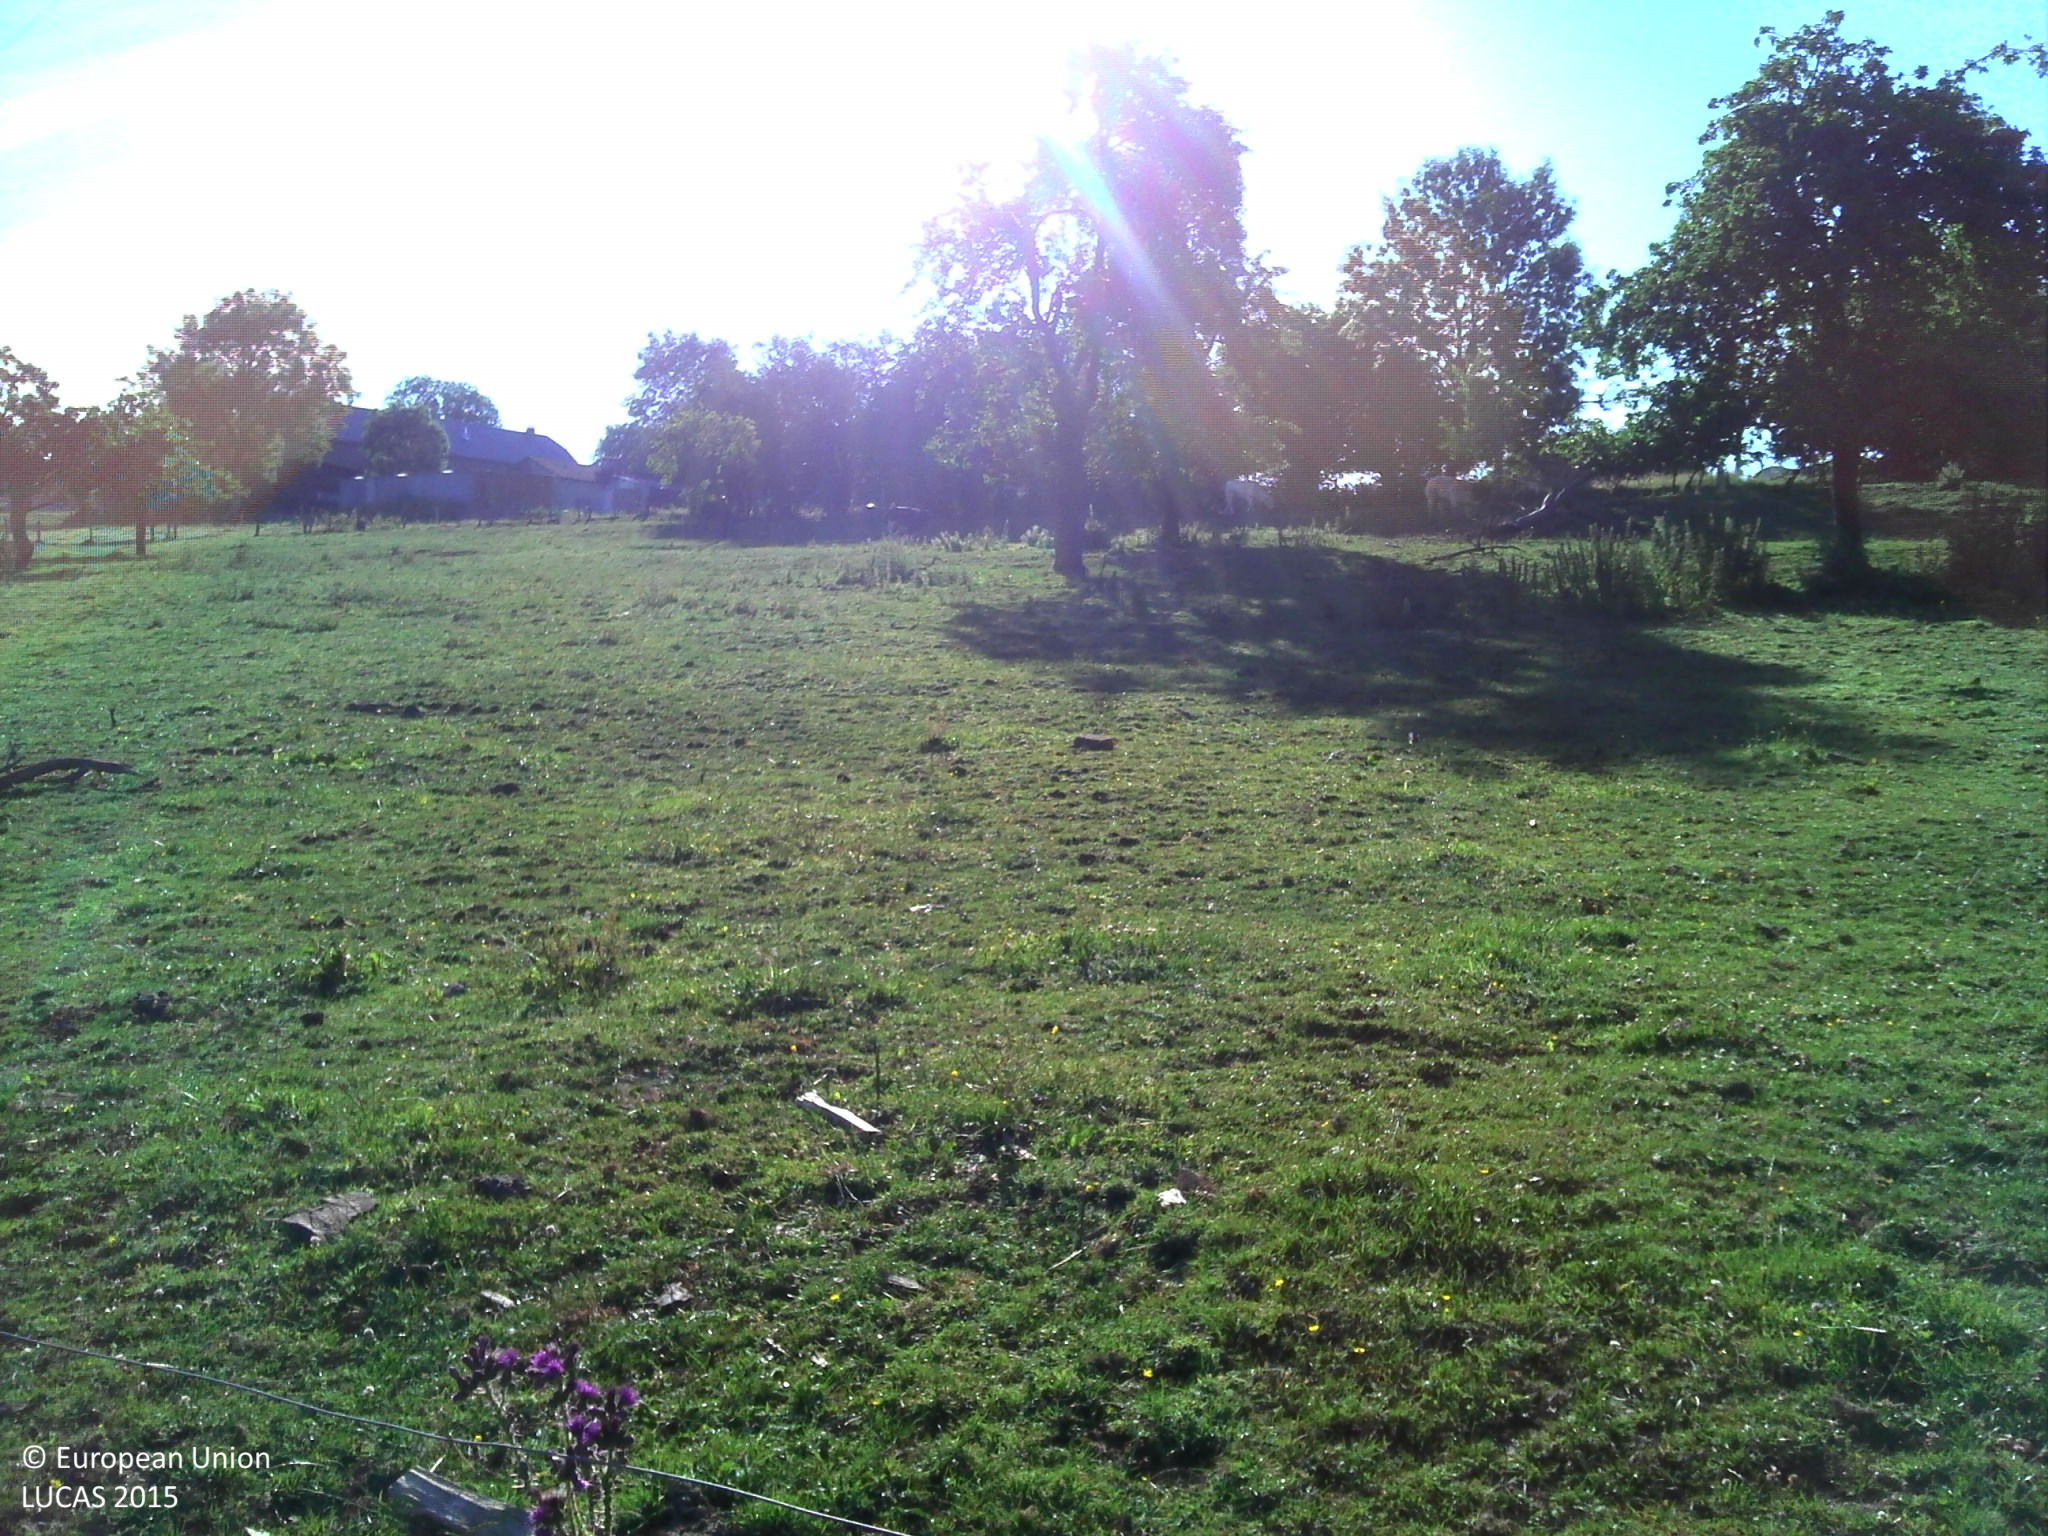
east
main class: Grassland
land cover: Grassland without tree/shrub cover
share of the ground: > 75 %
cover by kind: herbaceous plants 100 %
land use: Agriculture (excluding fallow land and kitchen gardens)
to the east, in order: Grassland without tree/shrub cover; Single bushes/trees; Grassland without tree/shrub cover; Fences; Grass margins; Fences; Grassland without tree/shrub cover; Artificial constructions in urban areas; Grassland without tree/shrub cover
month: July
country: BE
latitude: 50.1372
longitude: 5.6473
